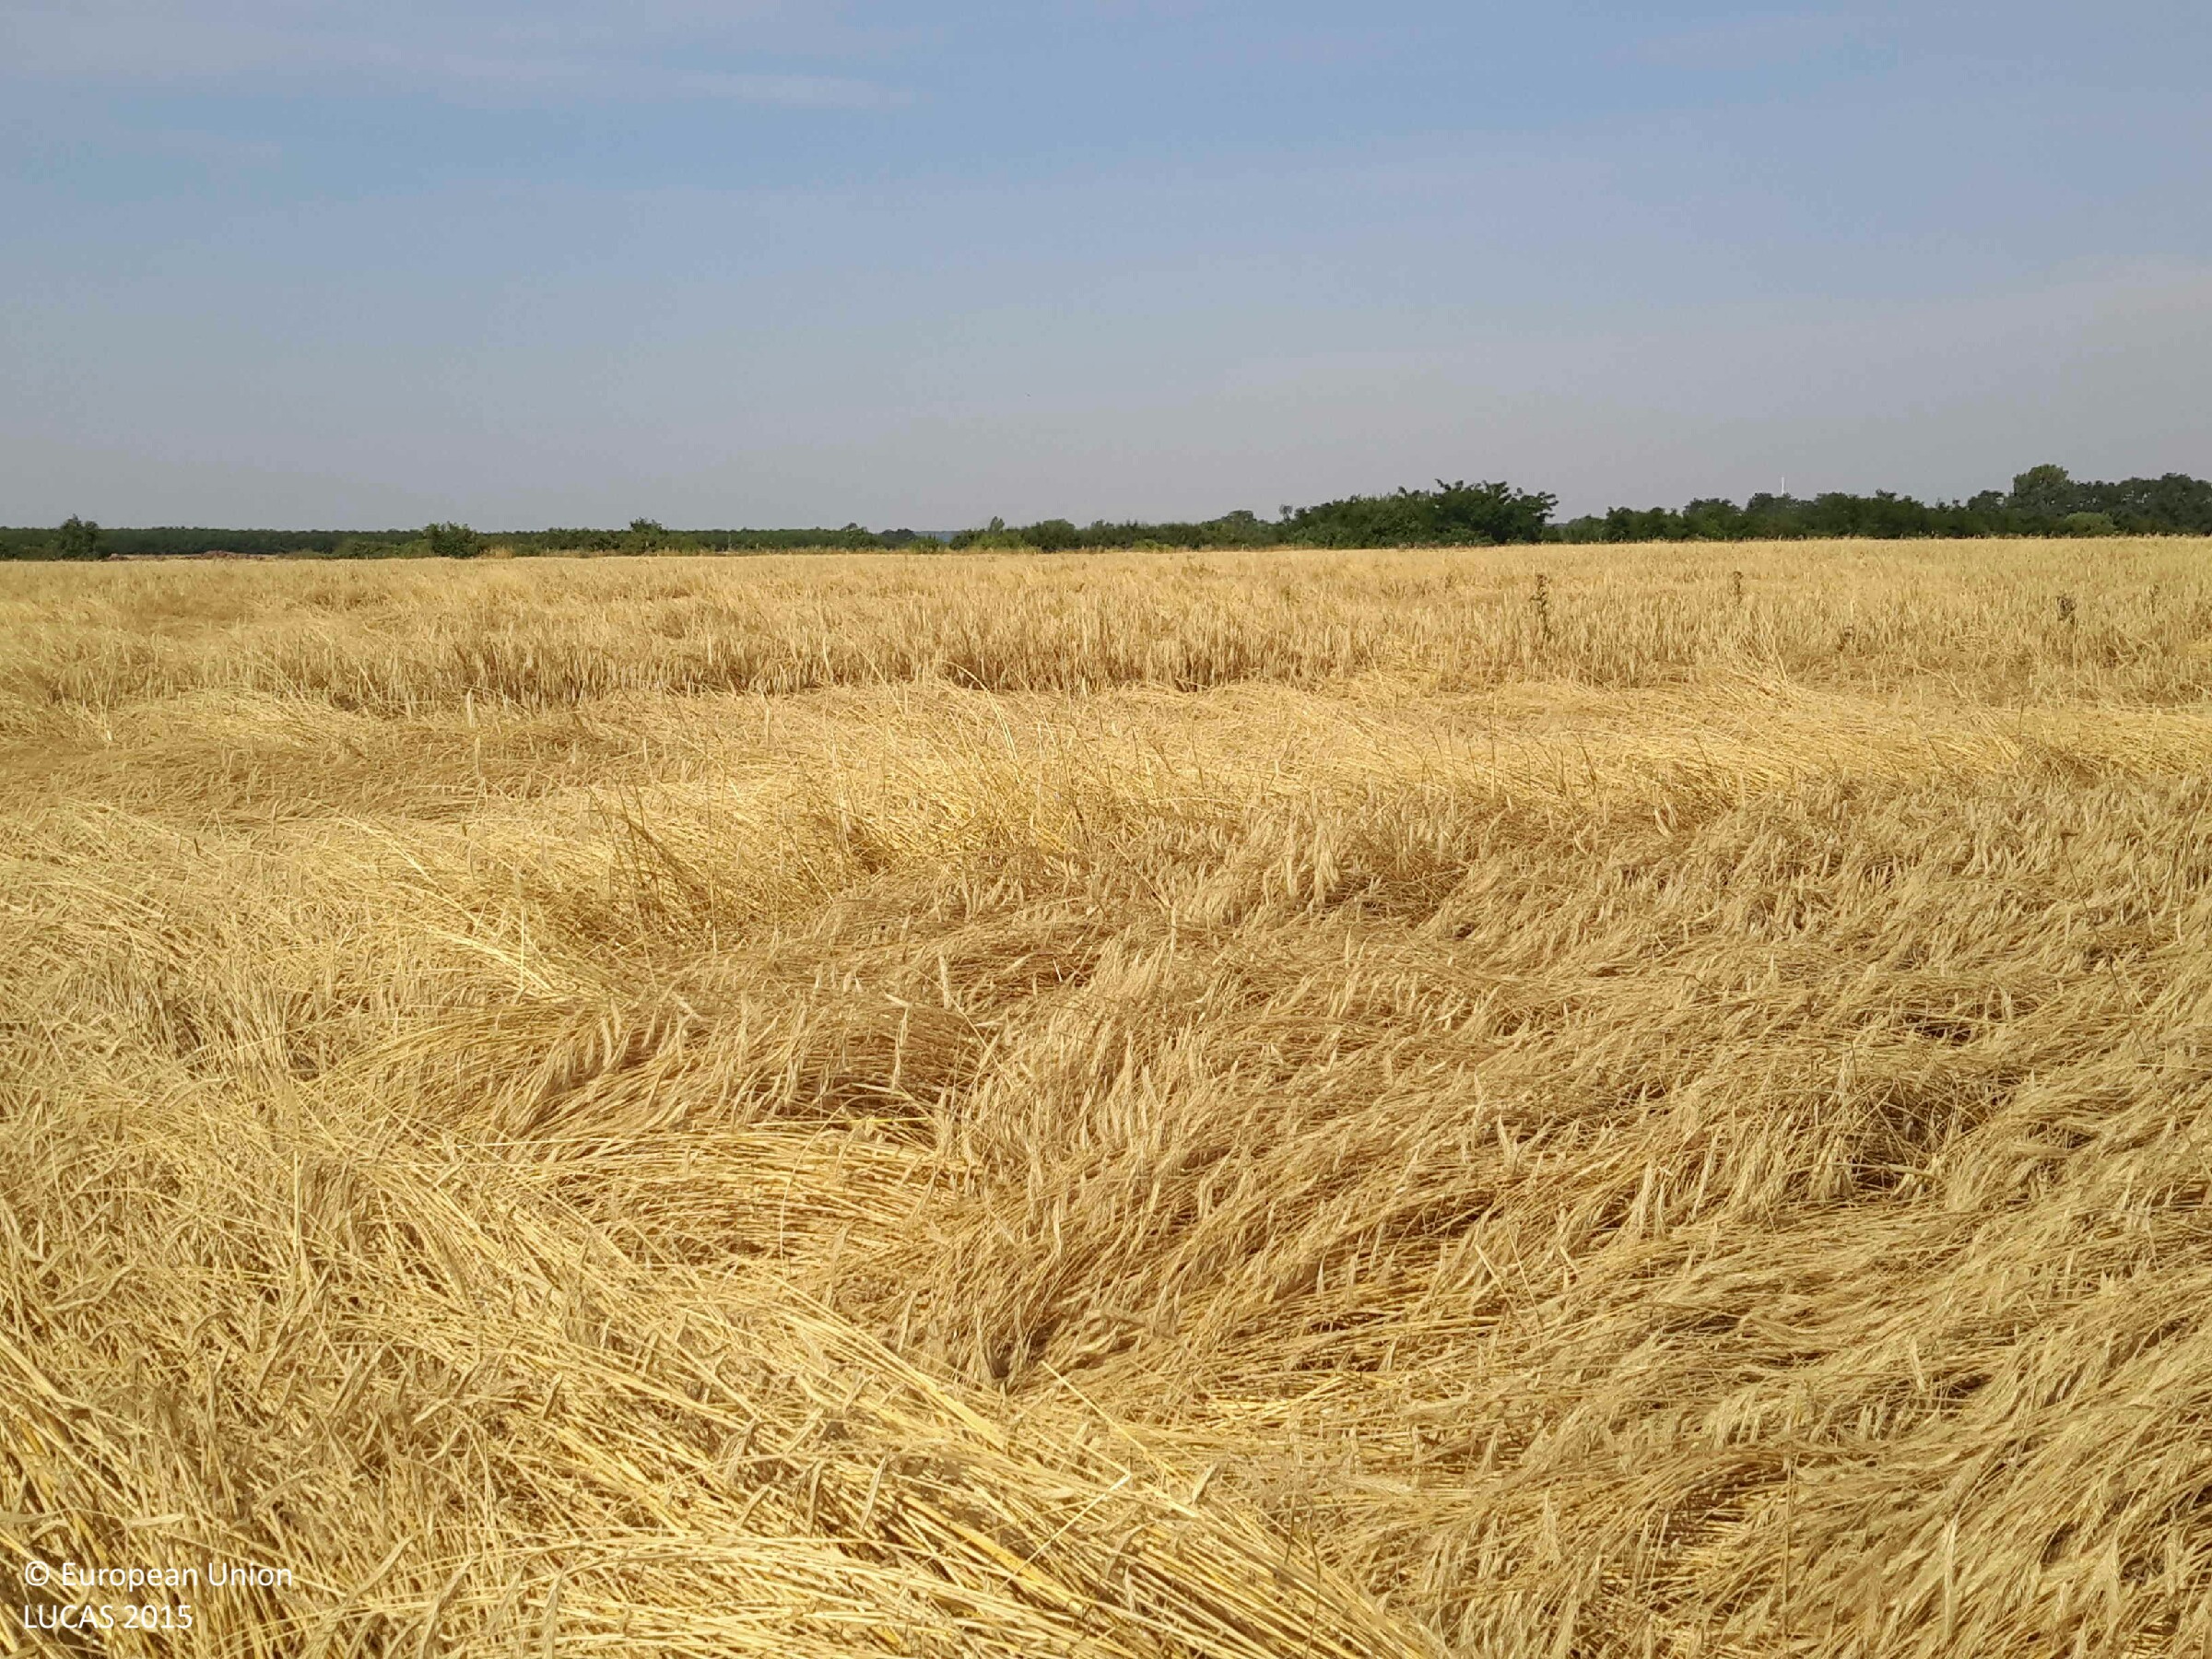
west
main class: Cropland
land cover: Common wheat
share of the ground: > 75 %
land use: Agriculture (excluding fallow land and kitchen gardens)
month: July
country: HU
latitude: 47.3184
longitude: 17.2164
